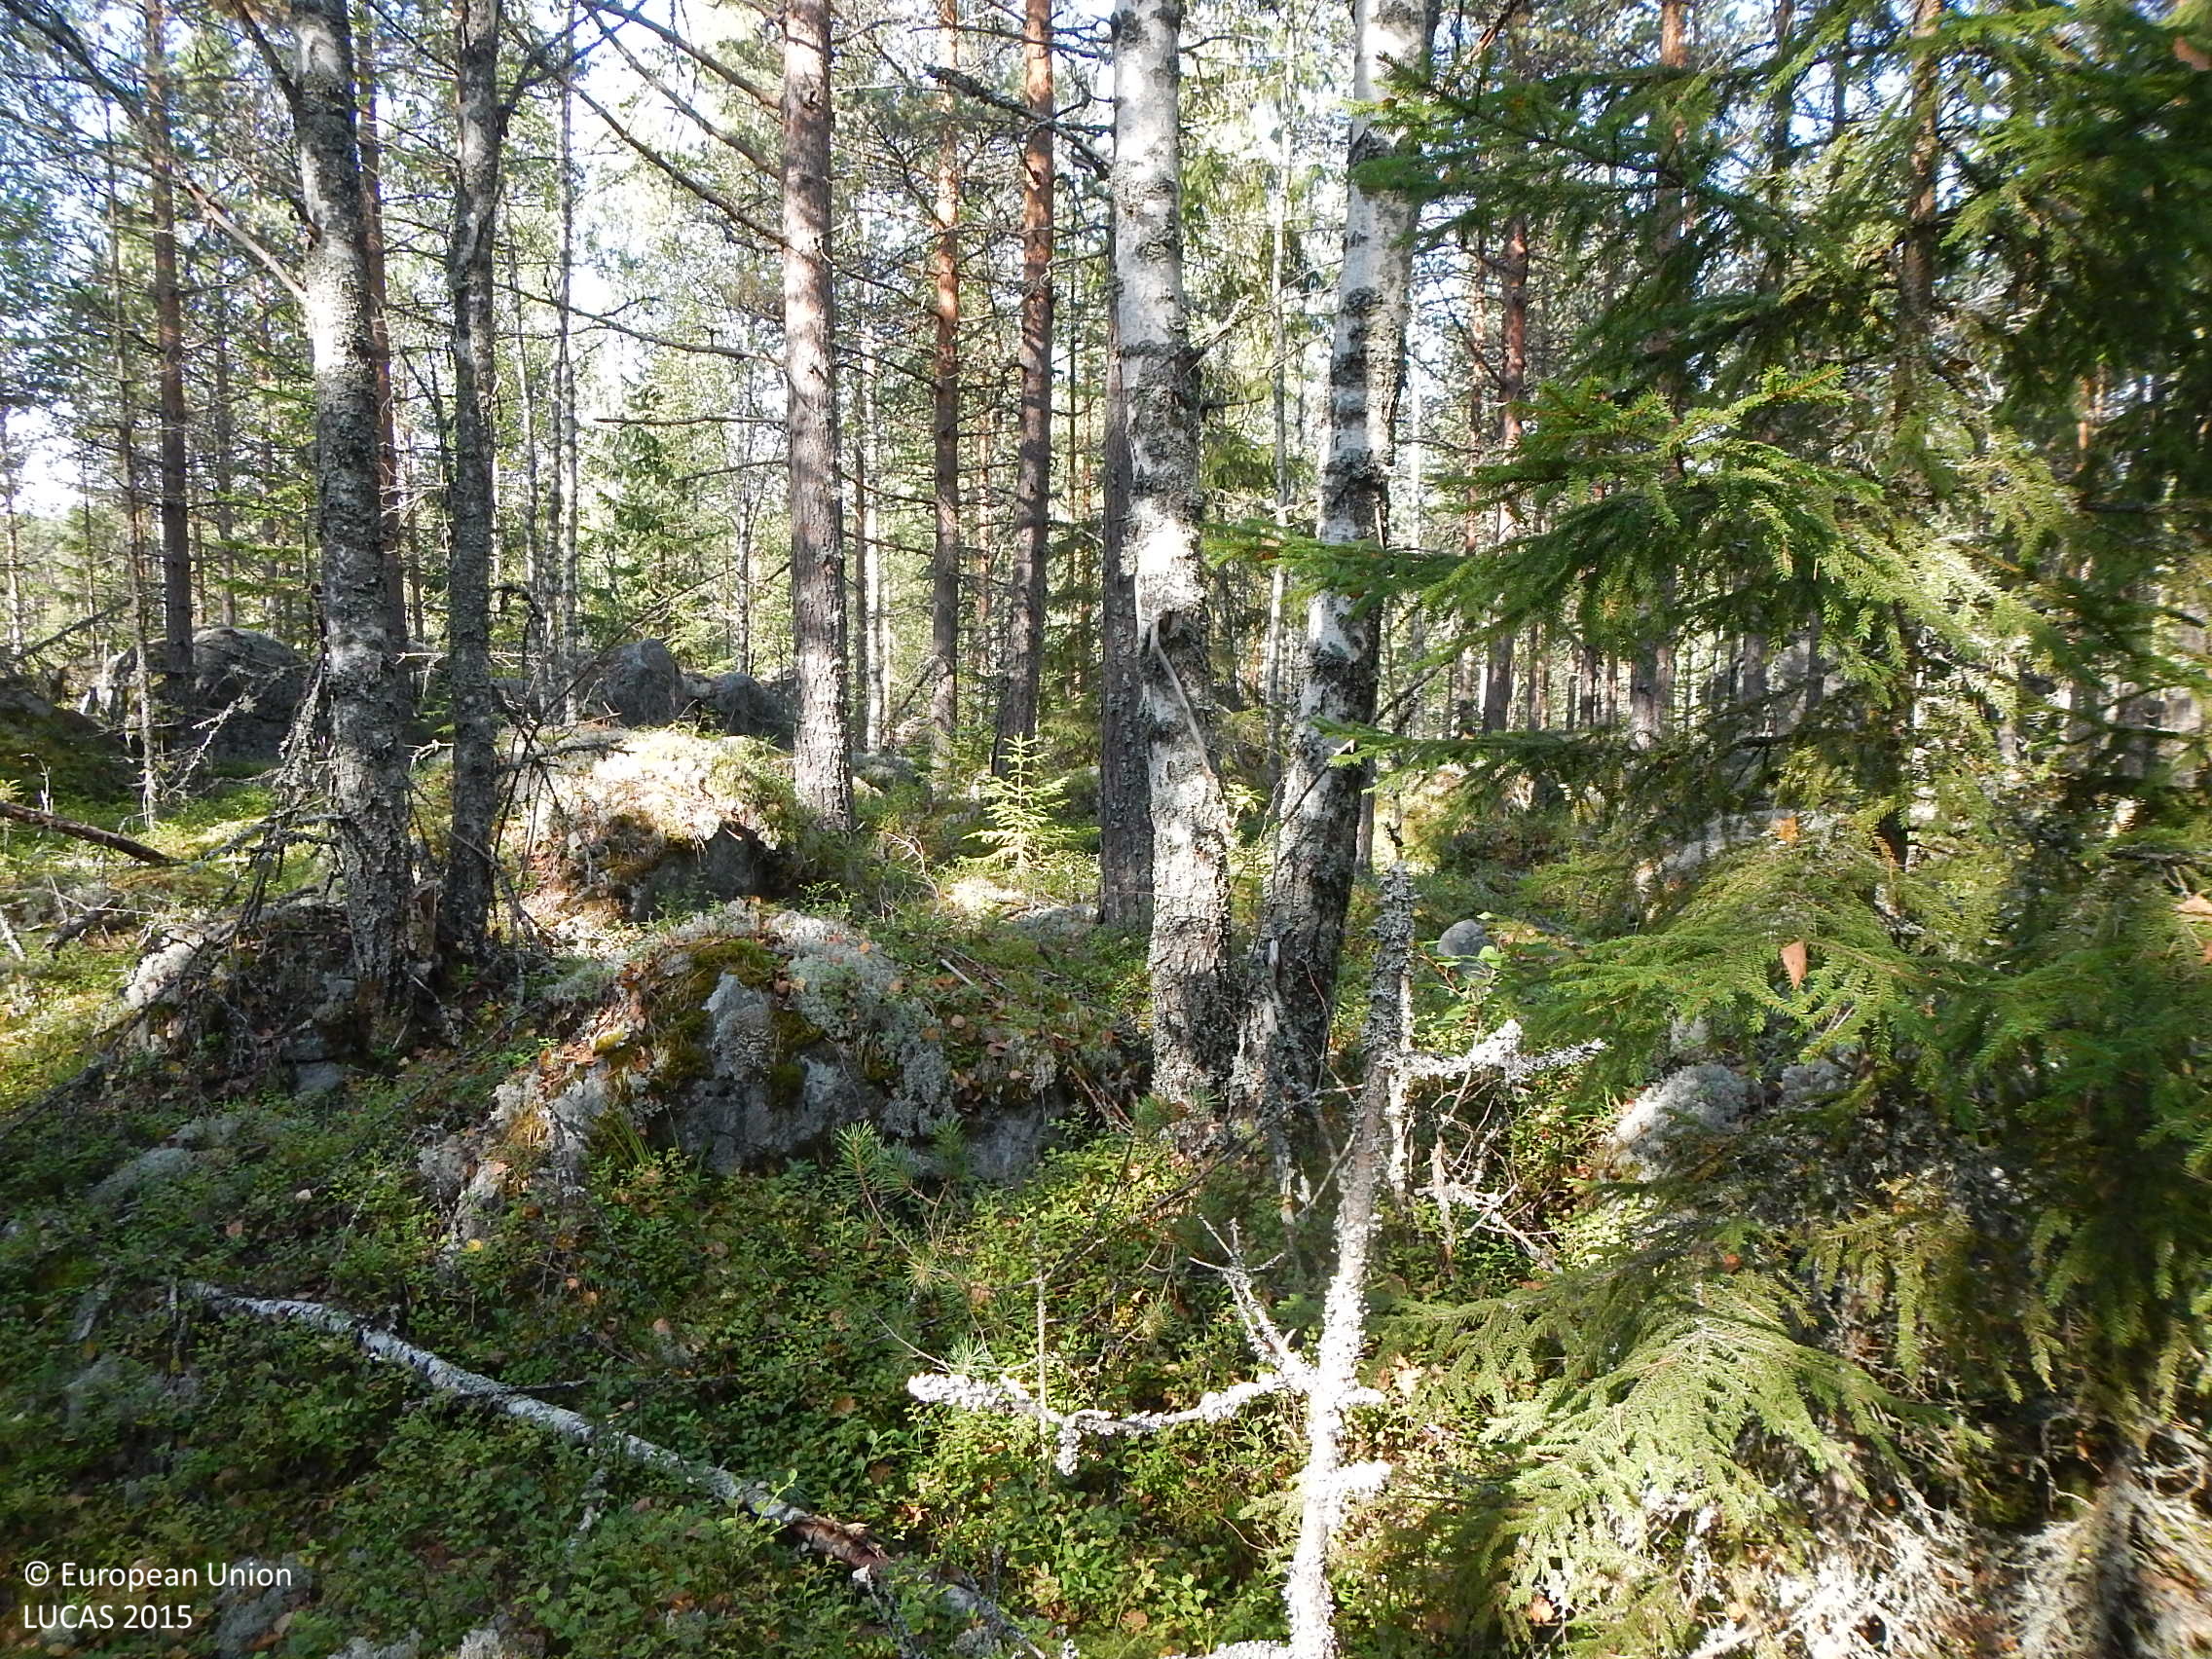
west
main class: Woodland
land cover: Other mixed woodland
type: boreal forest
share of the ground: > 75 %
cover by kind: coniferous forest trees 50 %, broadleaved forest trees 25 %, shrubs 20 %, lichens and mosses 5 %
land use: Forestry
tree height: > 5 m
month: September
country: FI
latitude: 61.5865
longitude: 22.1717
